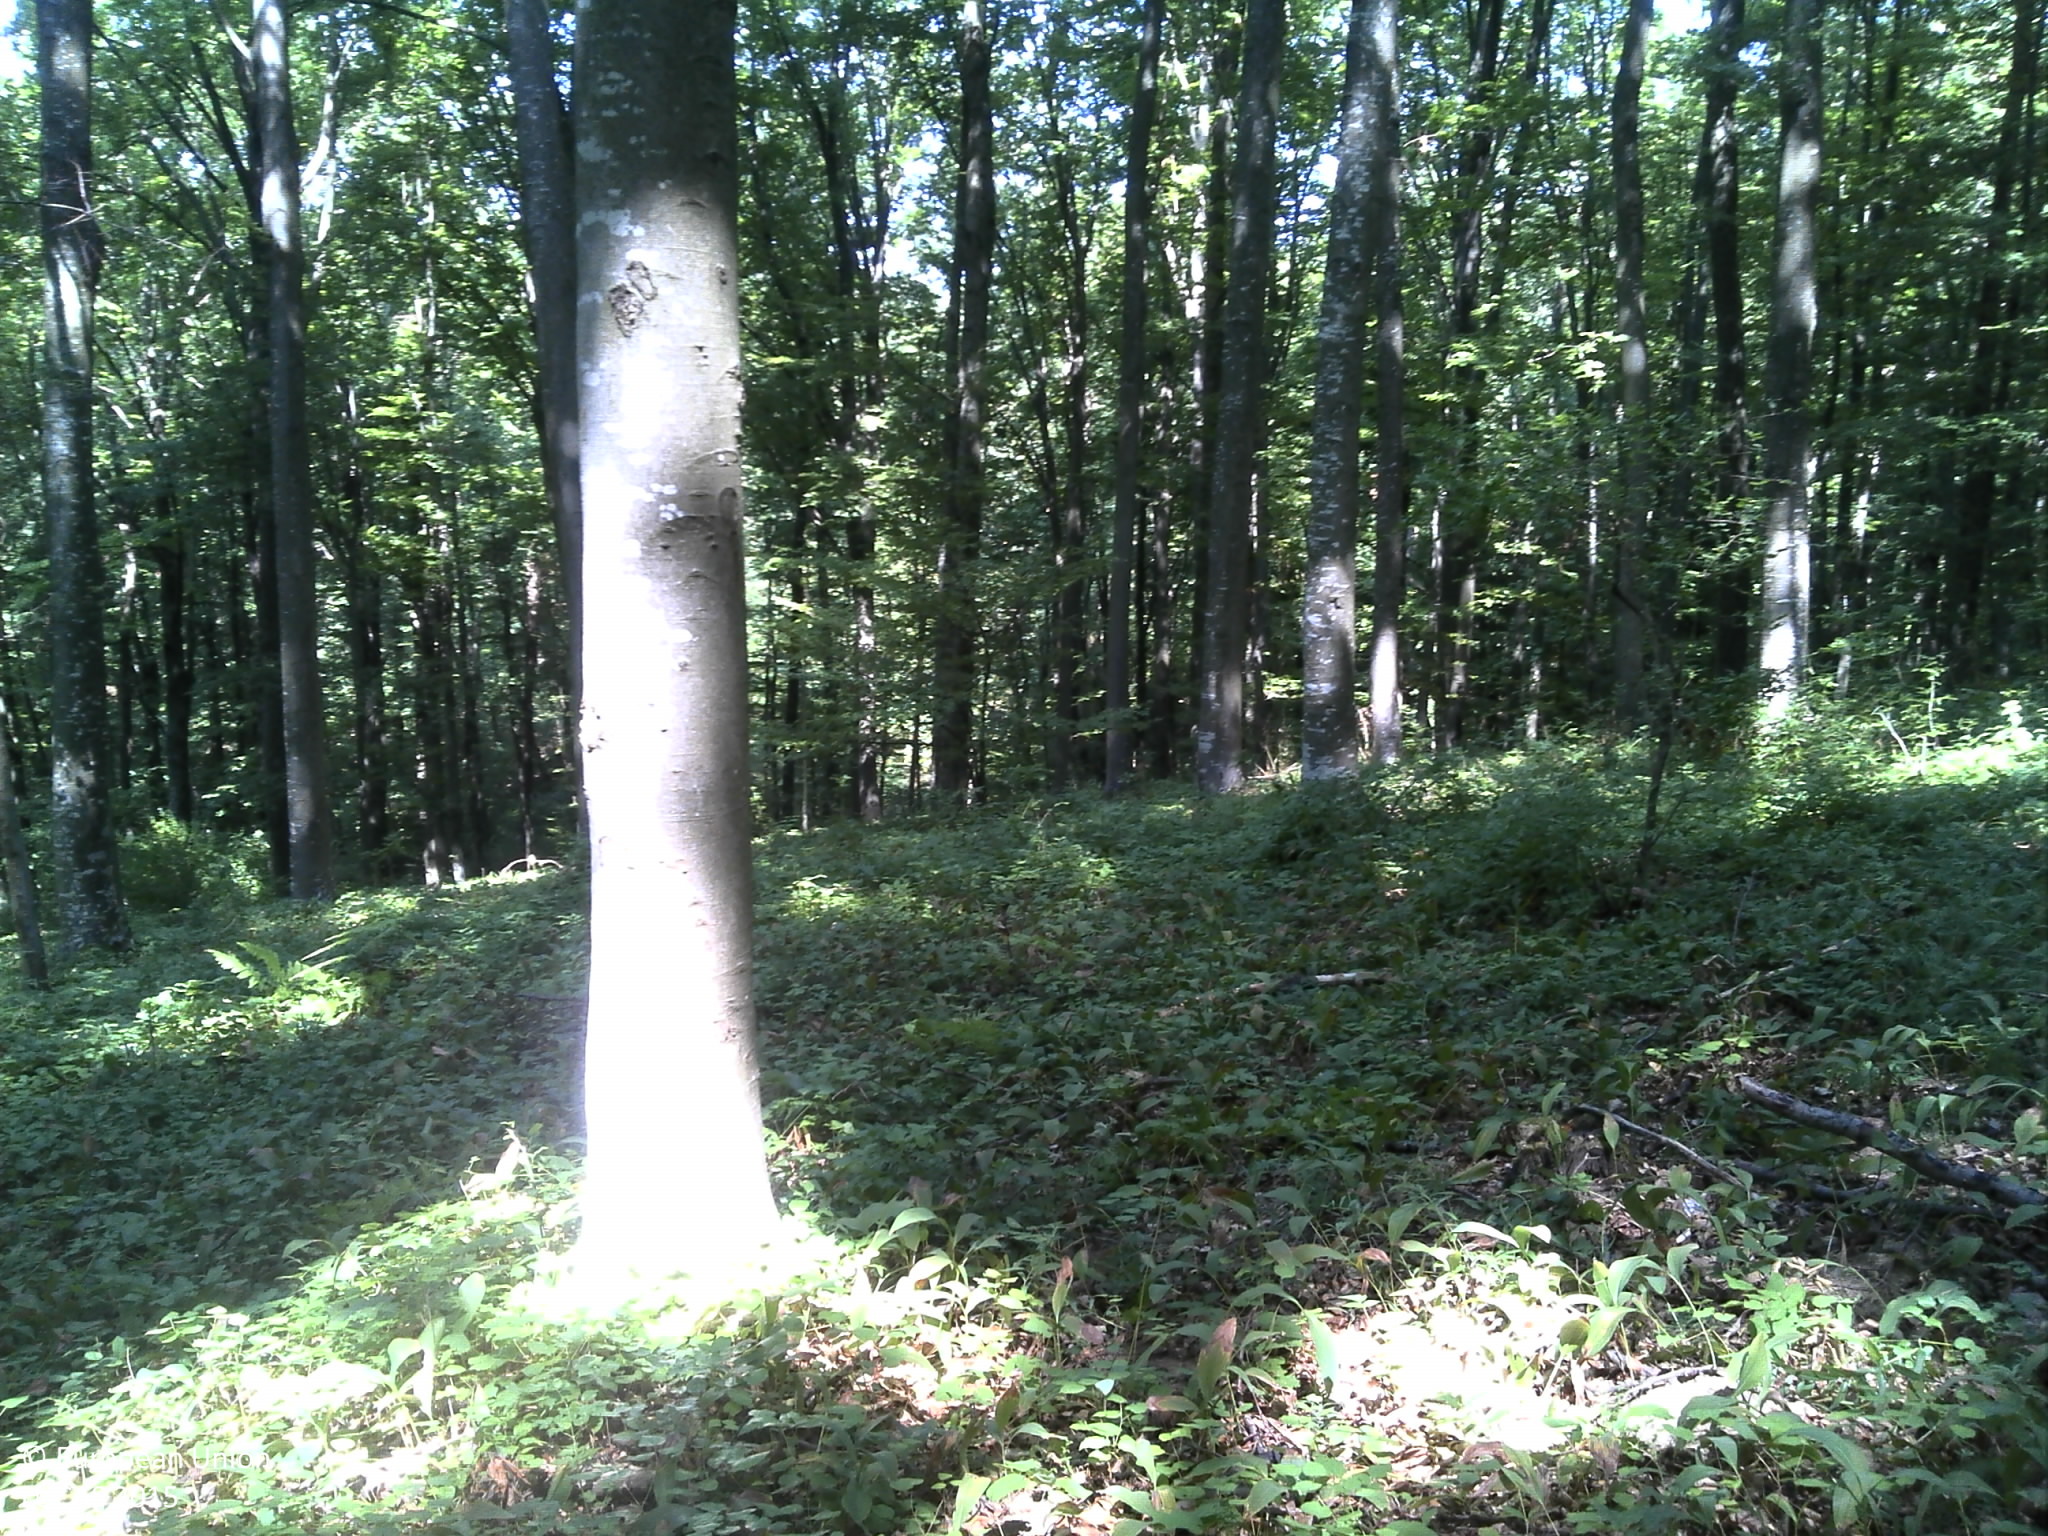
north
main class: Woodland
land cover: Broadleaved woodland
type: acidophilous oak and oak-birch forest
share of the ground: > 75 %
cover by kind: broadleaved forest trees 100 %
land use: Forestry
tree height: > 5 m
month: August
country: HR
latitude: 45.2712
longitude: 17.5337
